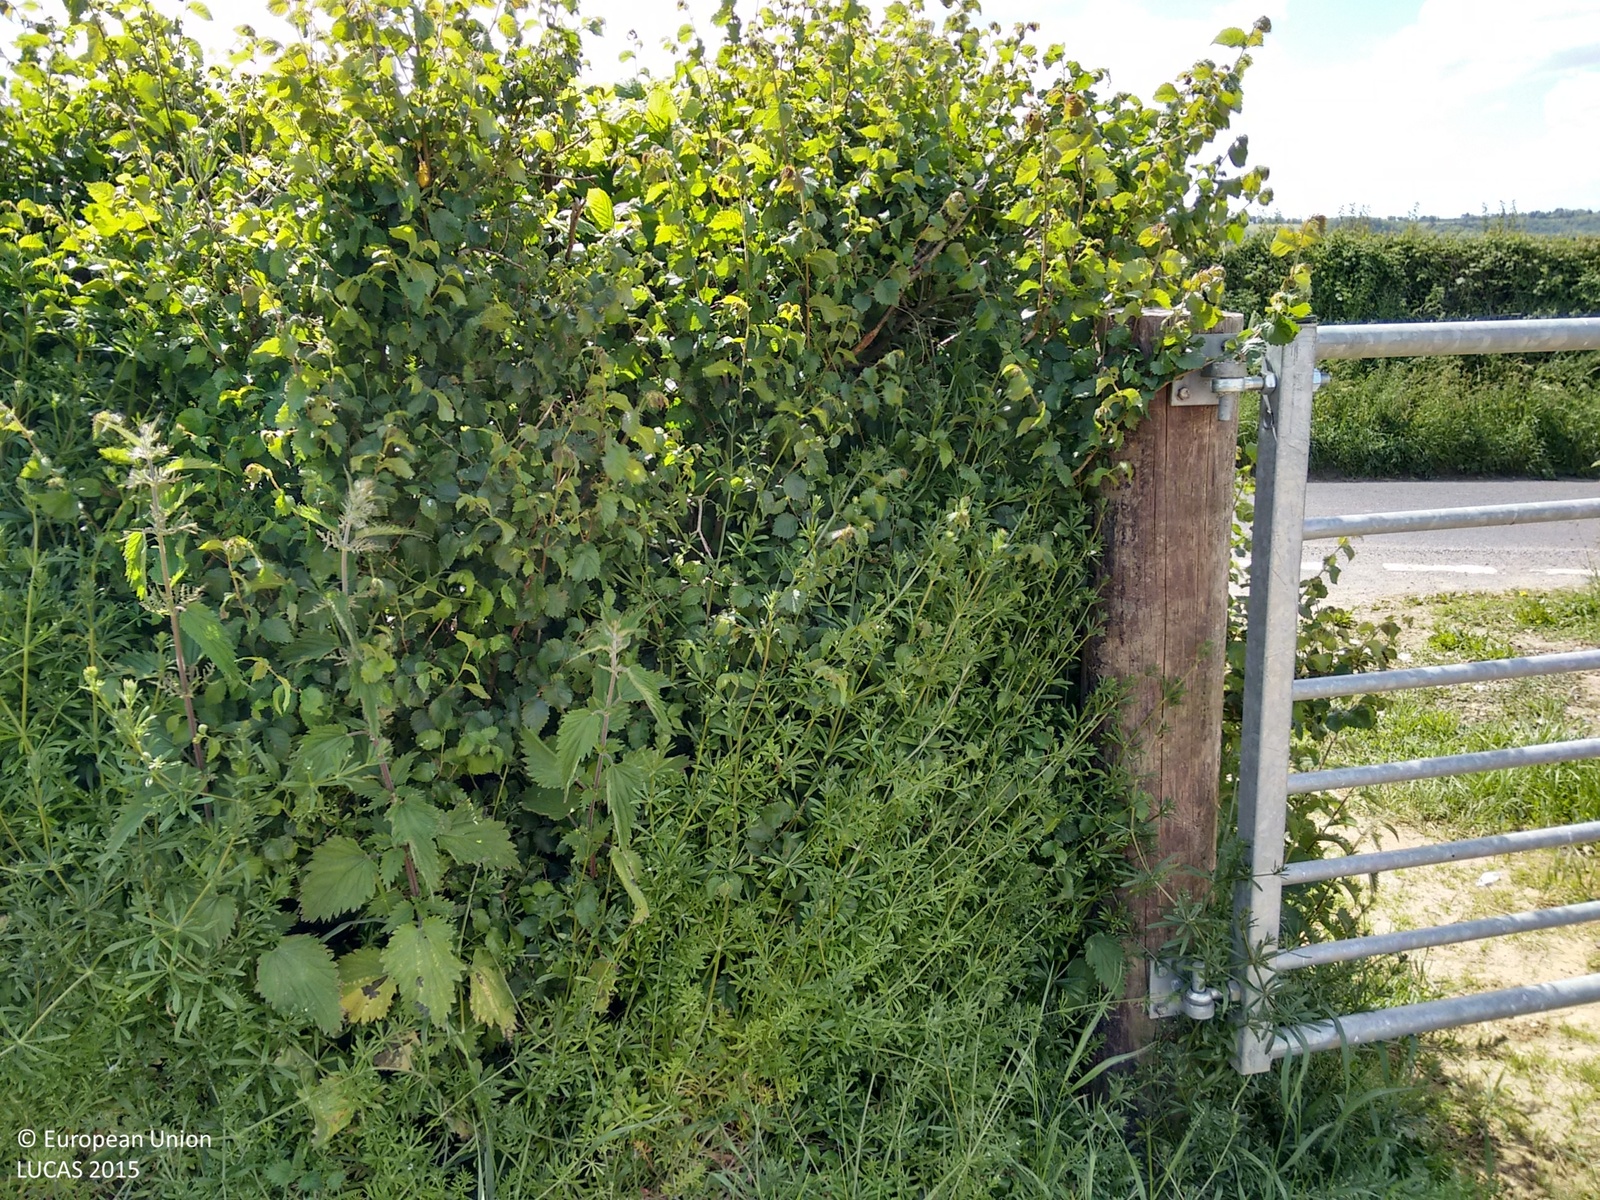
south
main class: Cropland
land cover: Maize
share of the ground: < 10 %
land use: Agriculture (excluding fallow land and kitchen gardens)
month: June
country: GB
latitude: 50.9095
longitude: -2.8579
